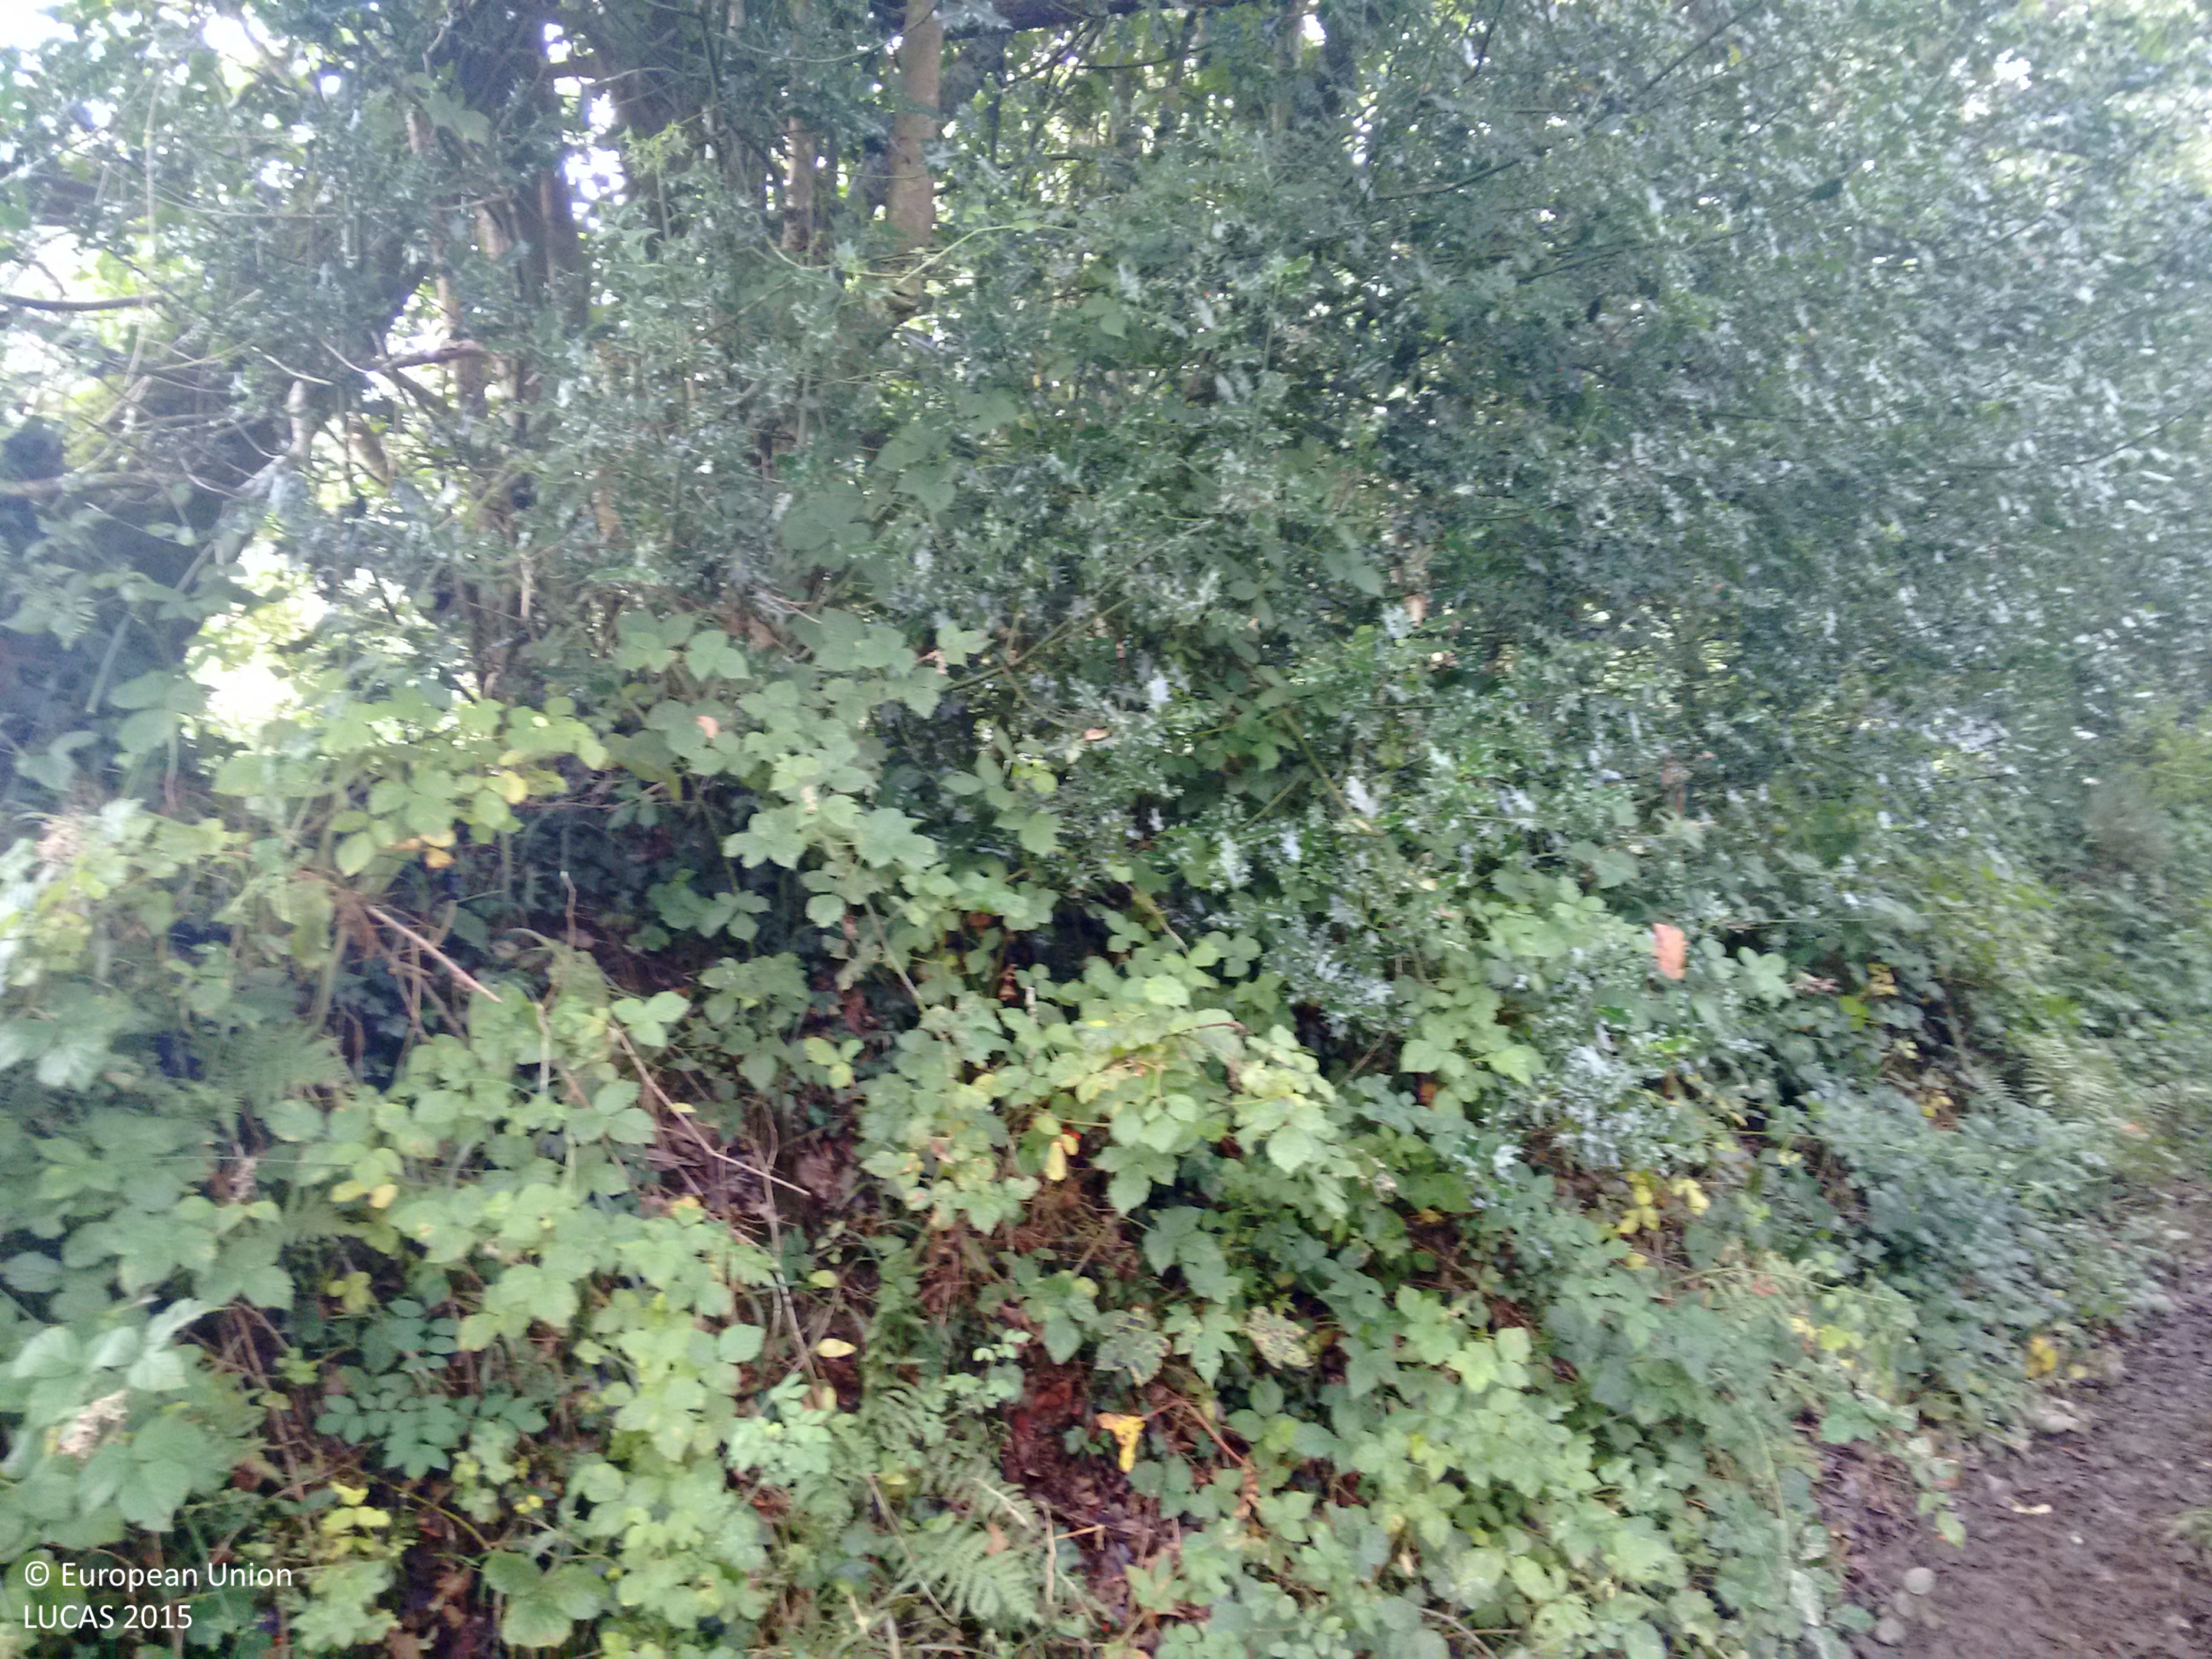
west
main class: Woodland
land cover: Broadleaved woodland
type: mesophytic deciduous forest
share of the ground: > 75 %
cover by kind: broadleaved forest trees 100 %
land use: Semi-natural and natural areas not in use
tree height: > 5 m
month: September
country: GB
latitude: 50.7507
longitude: -4.4908
